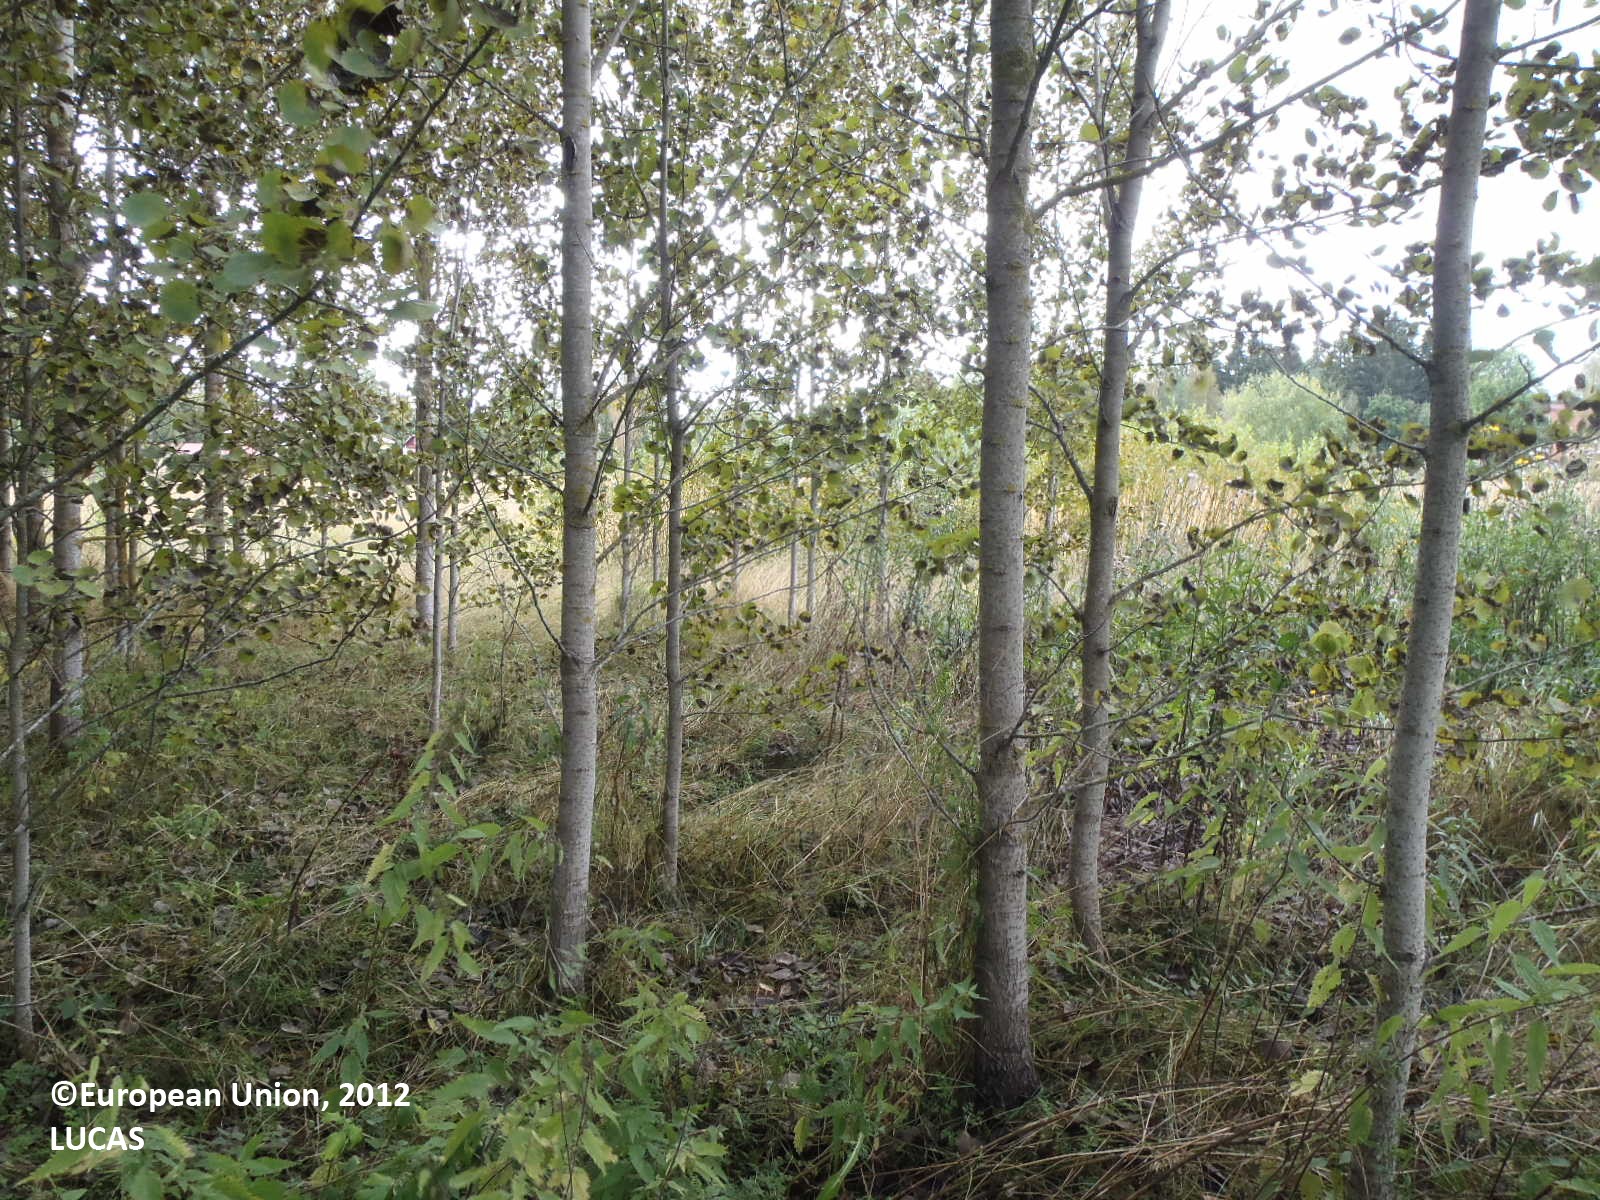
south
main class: Woodland
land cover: Broadleaved woodland
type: boreal forest
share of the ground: > 75 %
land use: Residential
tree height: > 5 m
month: September
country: FI
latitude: 61.2852
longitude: 22.6996
